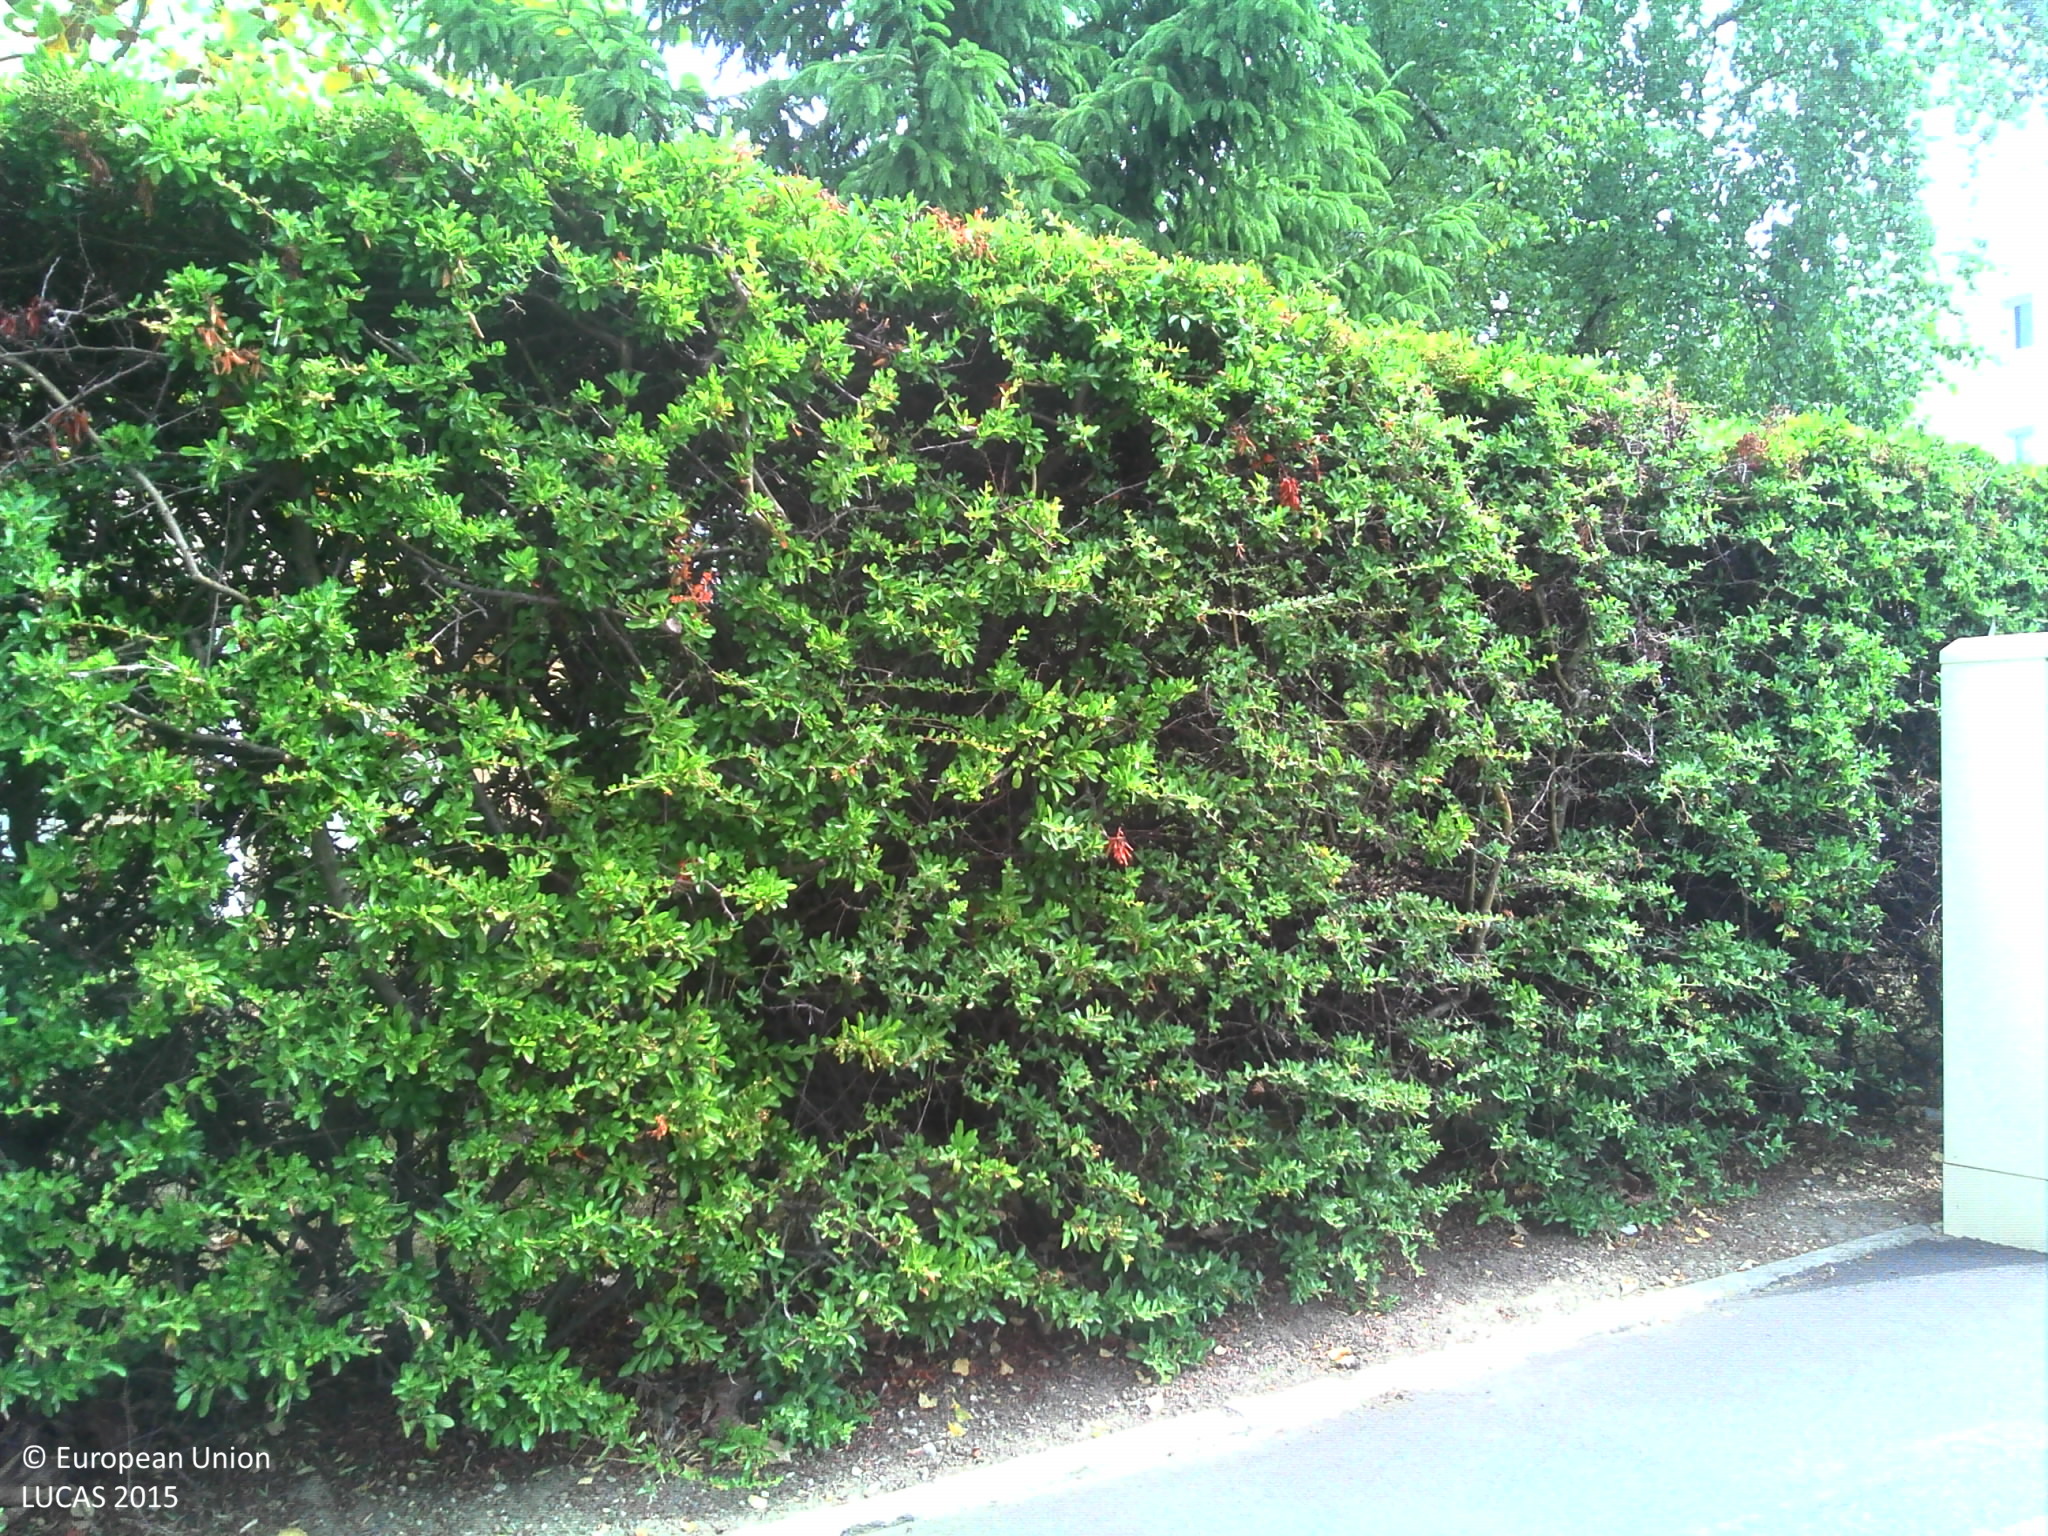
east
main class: Grassland
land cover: Grassland with sparse tree/shrub cover
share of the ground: > 75 %
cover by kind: herbaceous plants 80 %, broadleaved forest trees 5 %
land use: Residential
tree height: < 5 m
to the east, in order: Artificial constructions in urban areas
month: August
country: FR
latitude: 49.0035
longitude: 2.3188
